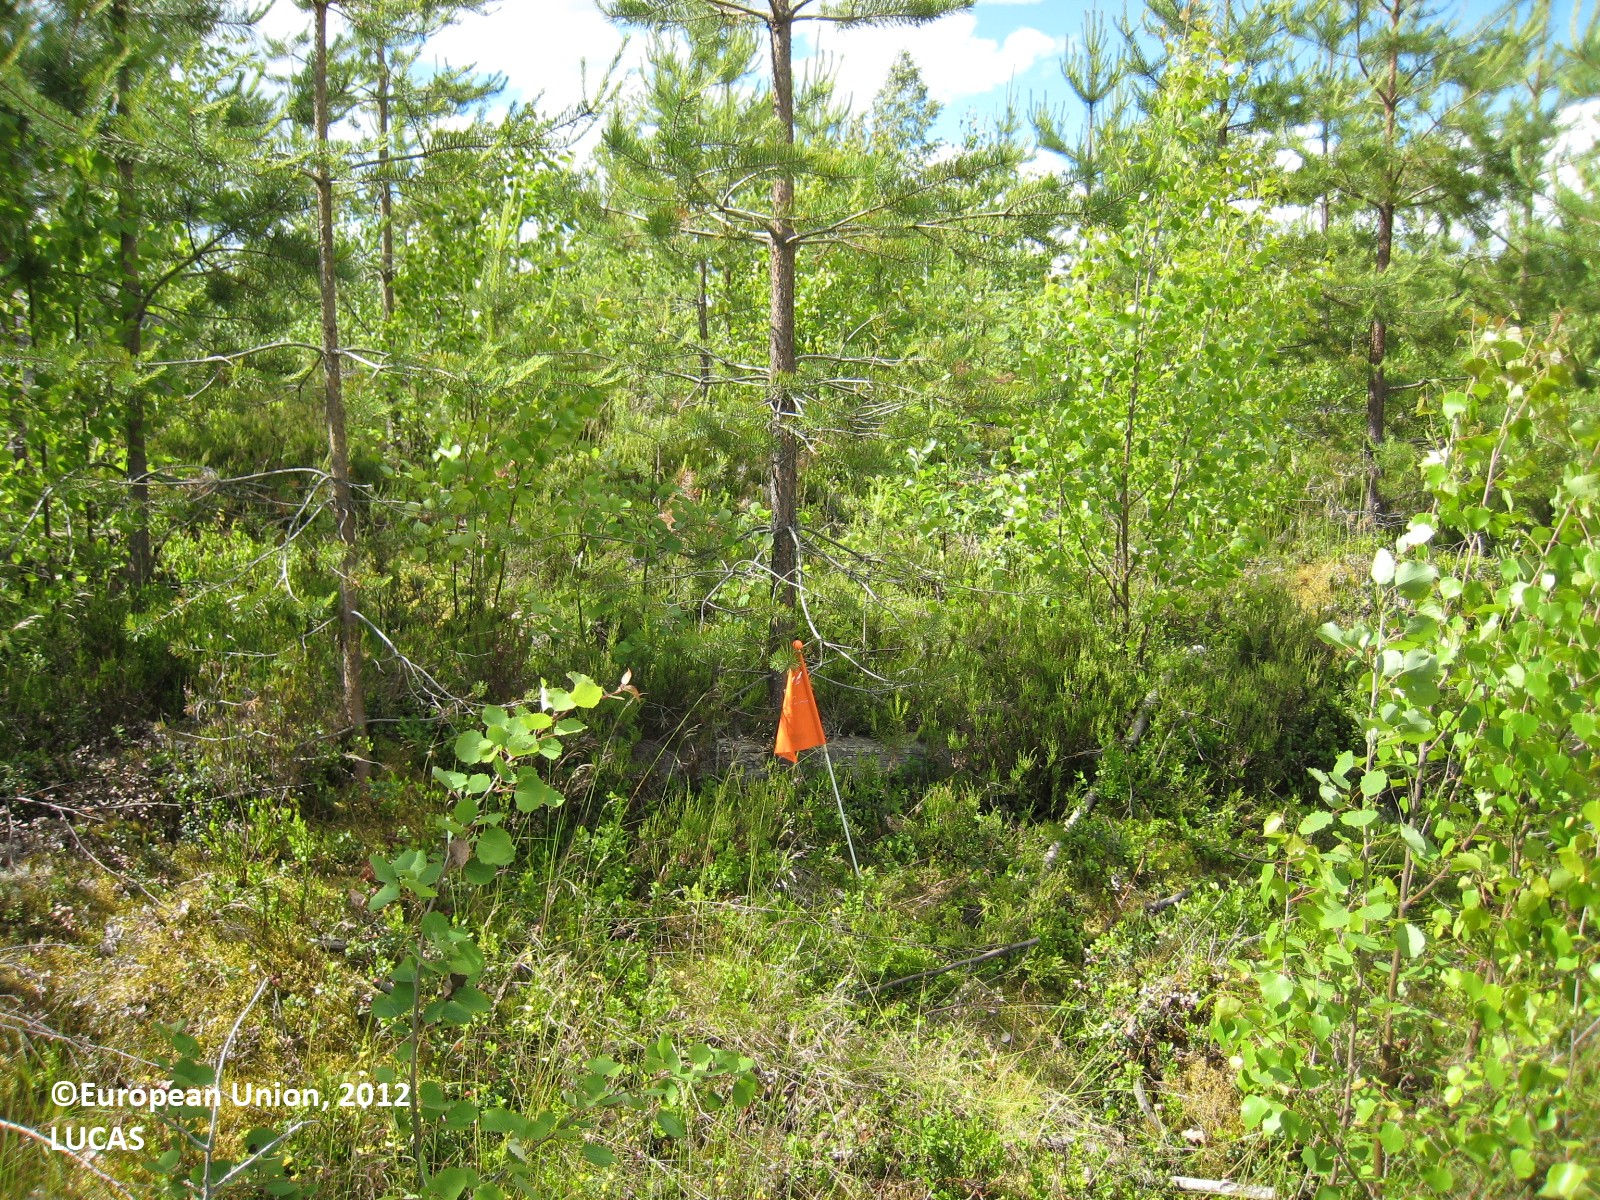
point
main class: Woodland
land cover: Pine dominated mixed woodland
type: boreal forest
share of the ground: 50 - 75 %
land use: Forestry
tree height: < 5 m
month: July
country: FI
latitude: 62.8351
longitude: 25.6818
